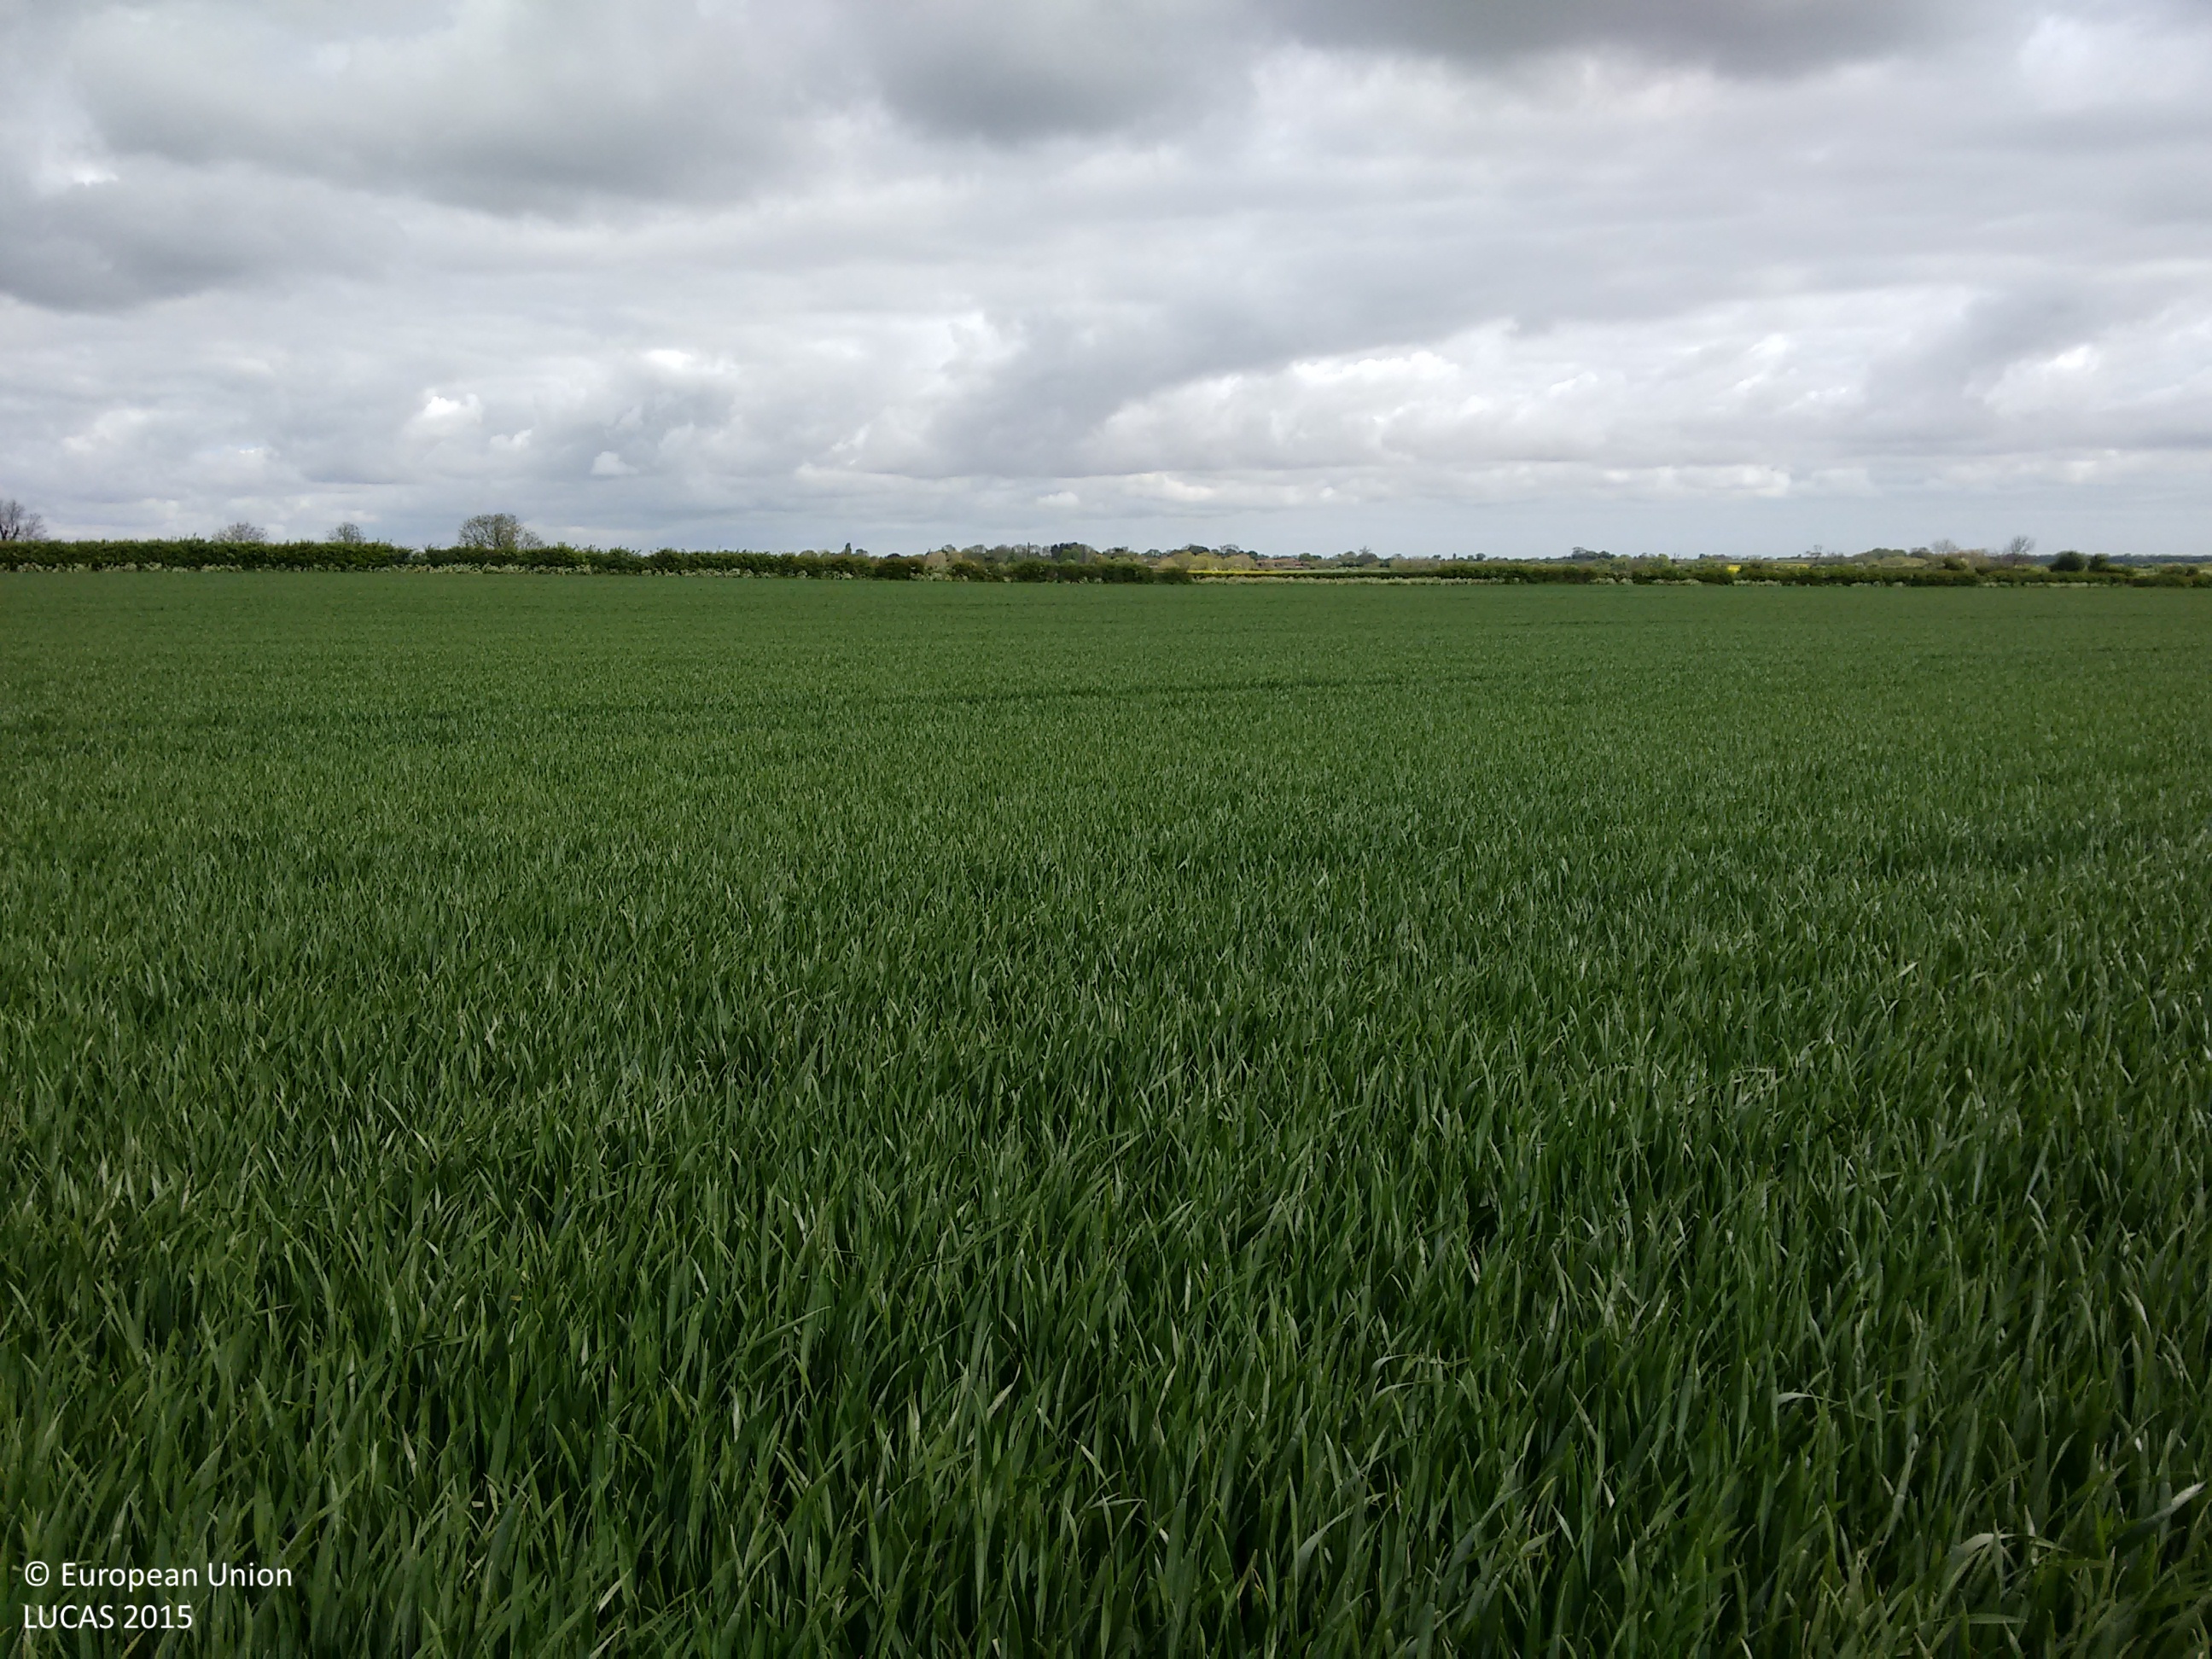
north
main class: Cropland
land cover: Common wheat
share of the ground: > 75 %
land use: Agriculture (excluding fallow land and kitchen gardens)
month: May
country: GB
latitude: 53.5101
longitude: -0.0294
